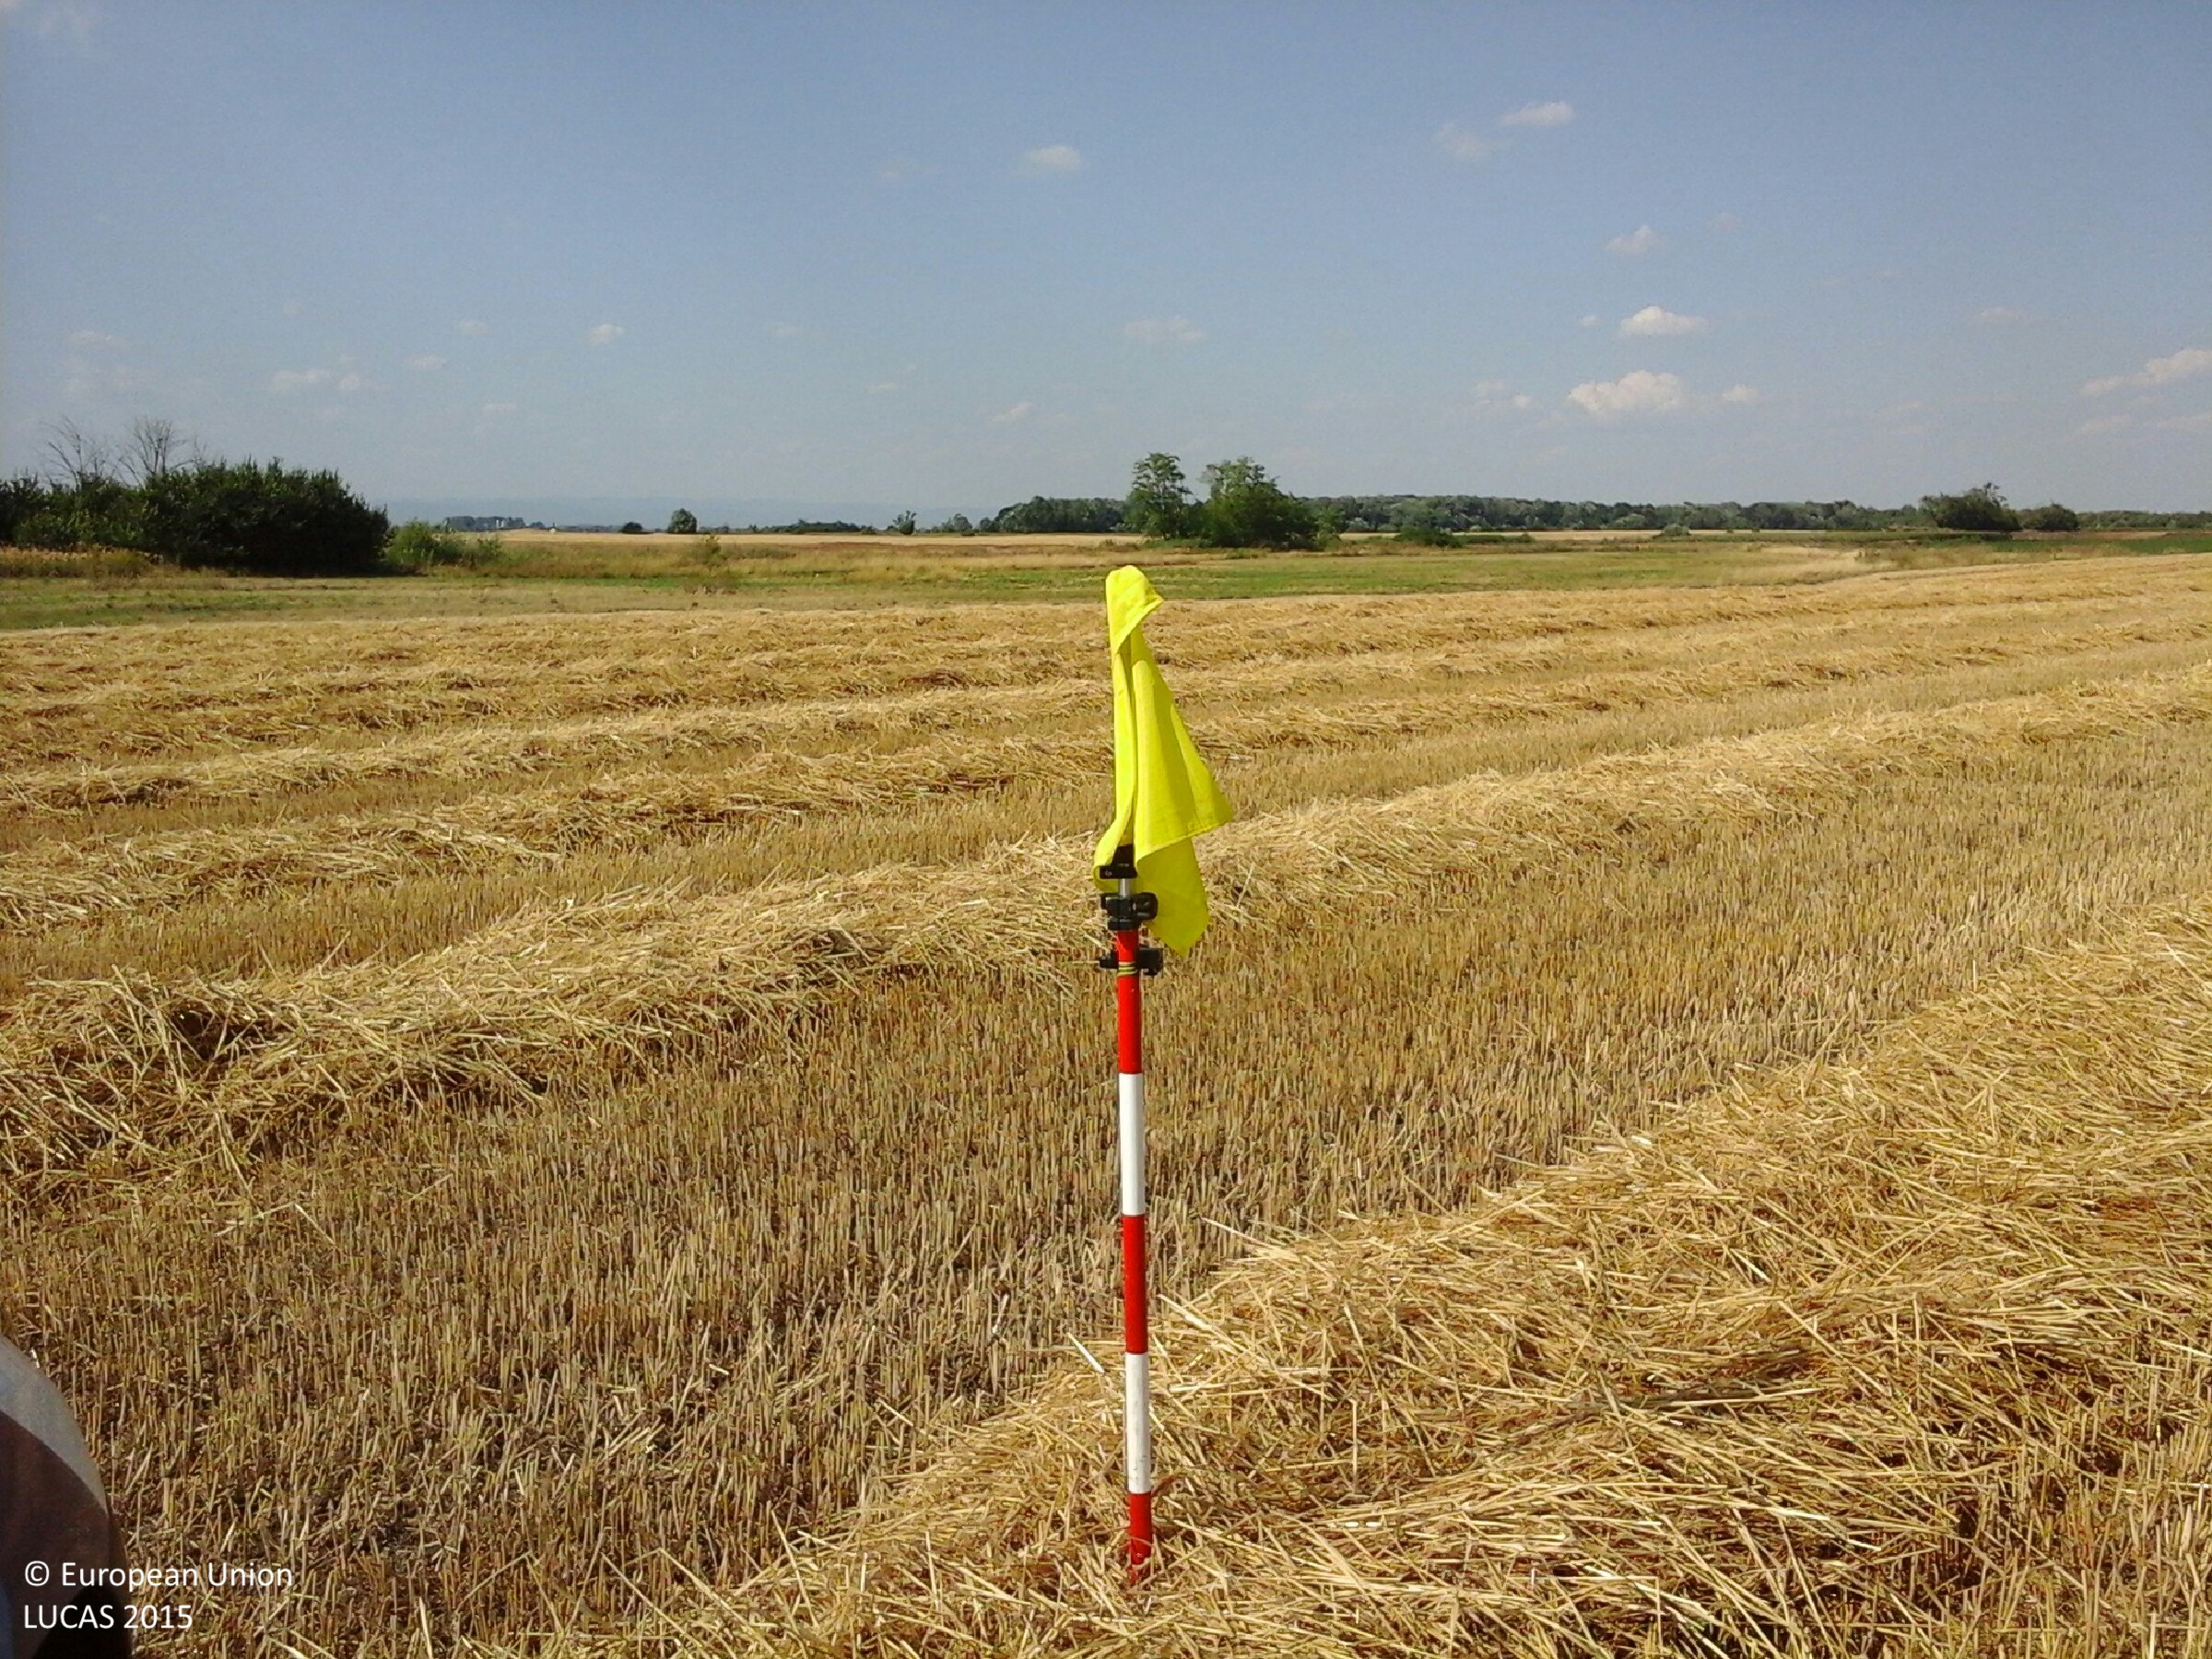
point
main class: Cropland
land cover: Common wheat
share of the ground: 50 - 75 %
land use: Agriculture (excluding fallow land and kitchen gardens)
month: July
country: HU
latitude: 47.6498
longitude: 20.4822
